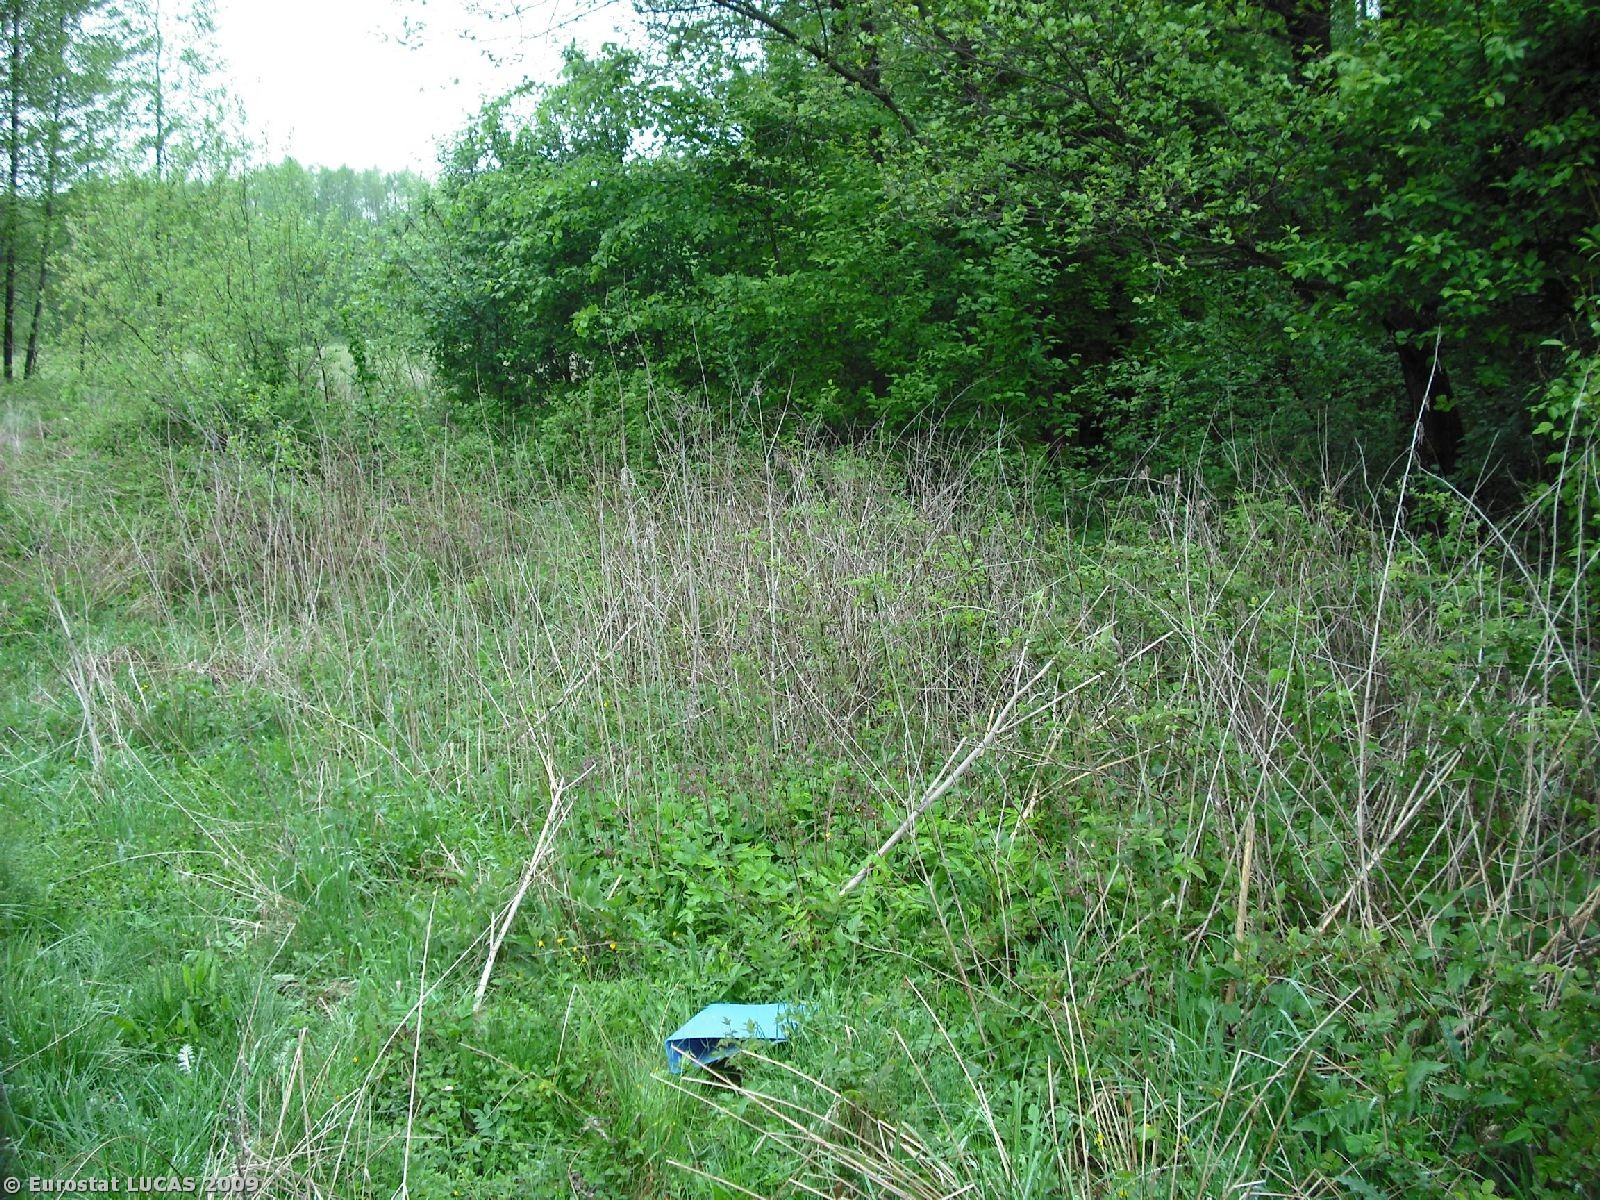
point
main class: Grassland
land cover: Grassland with sparse tree/shrub cover
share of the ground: > 75 %
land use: Unused
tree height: < 5 m
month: May
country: PL
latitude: 52.9752
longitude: 23.2893
